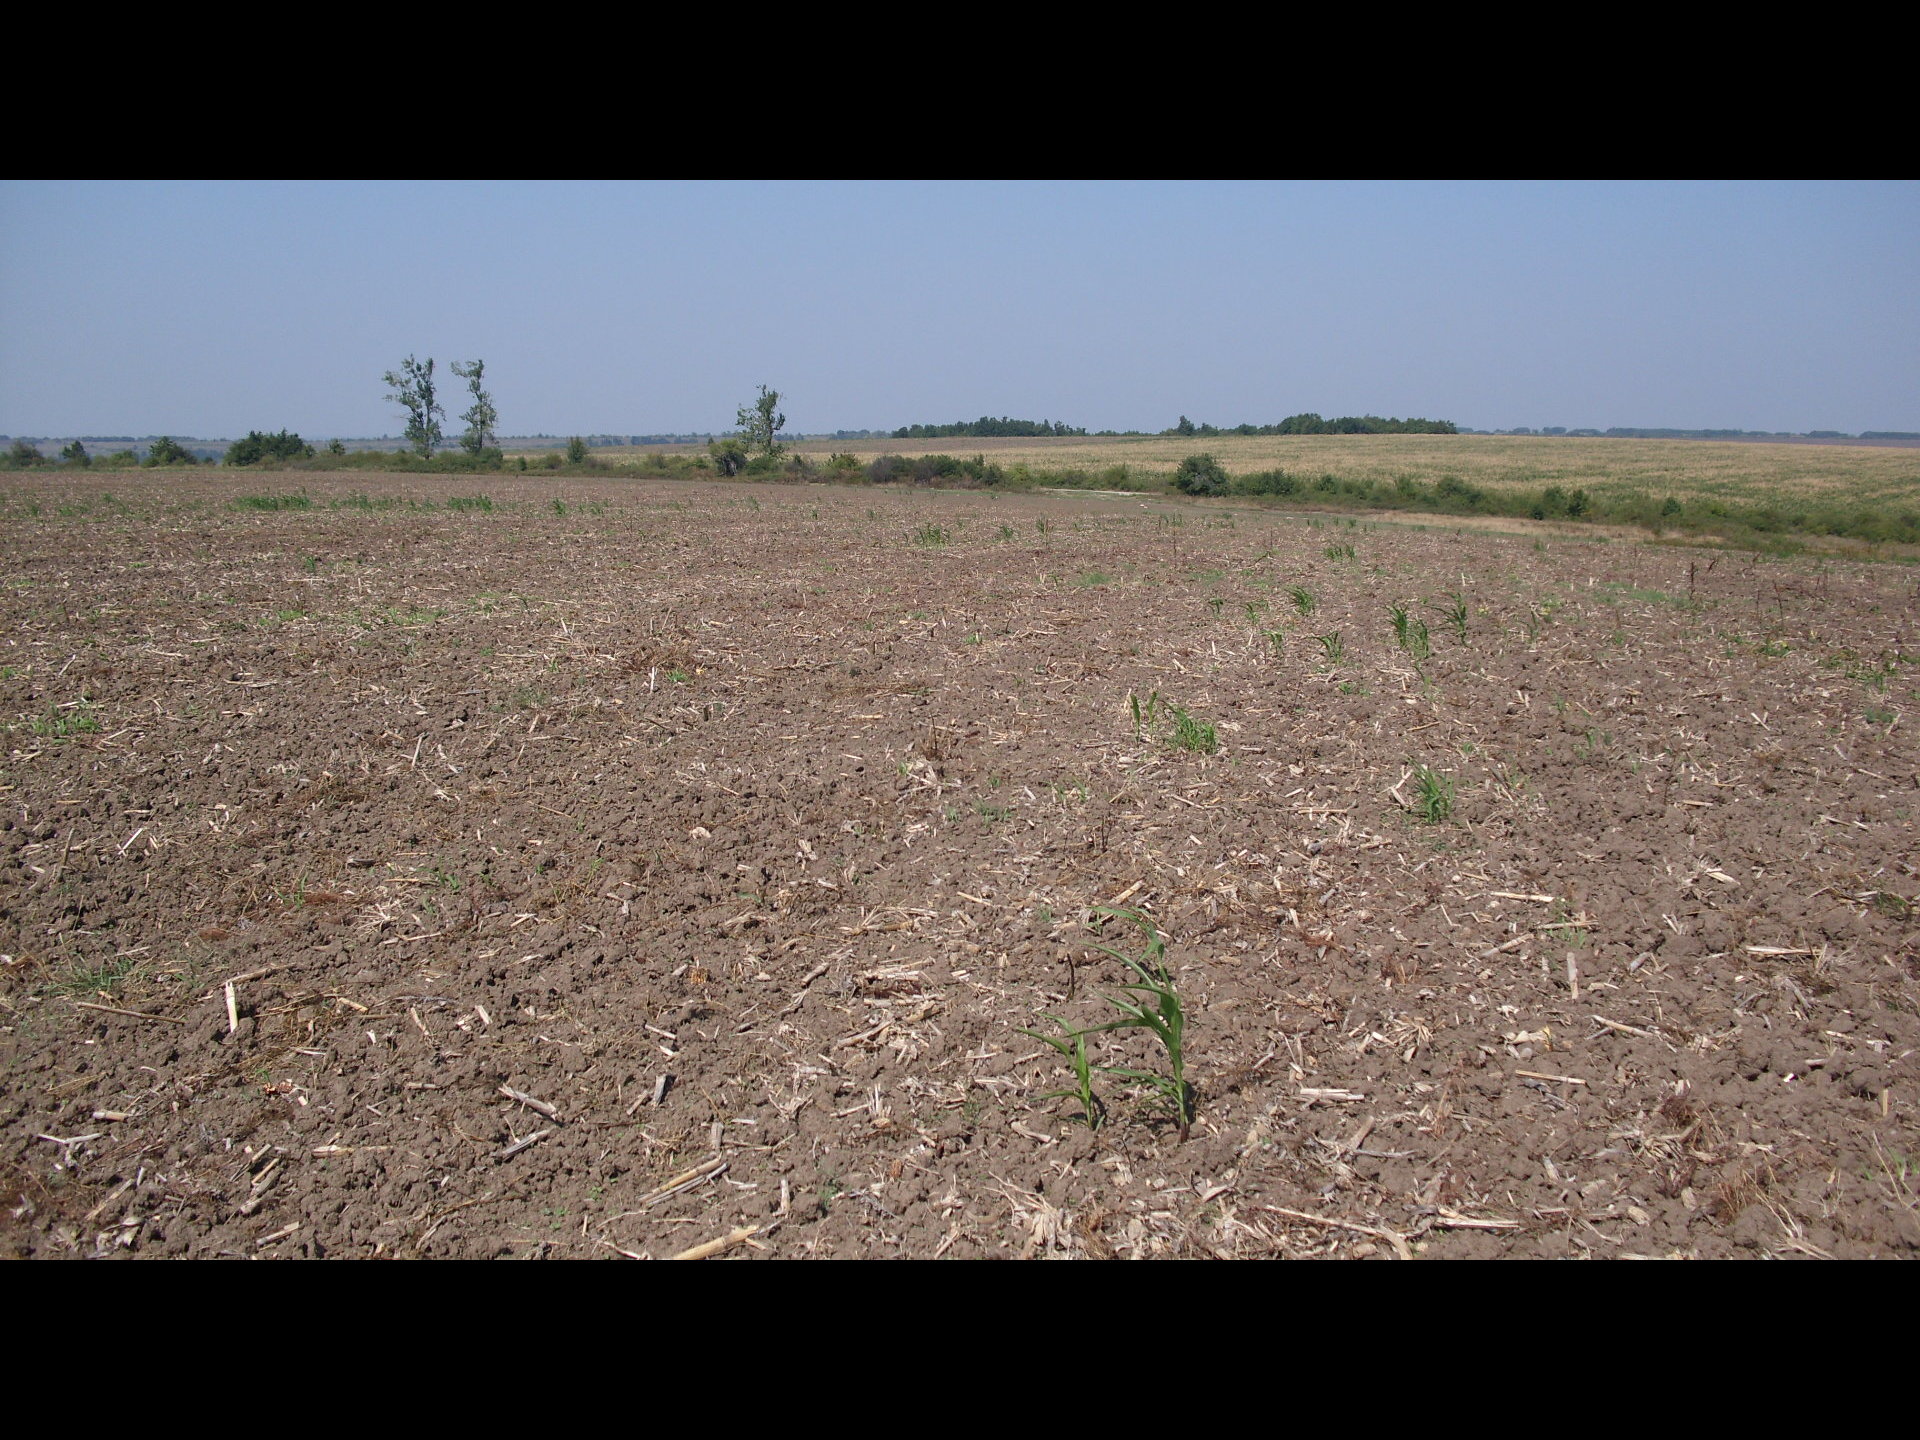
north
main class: Cropland
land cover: Maize
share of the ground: < 10 %
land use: Agriculture (excluding fallow land and kitchen gardens)
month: September
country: BG
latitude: 43.9906
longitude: 22.5160
